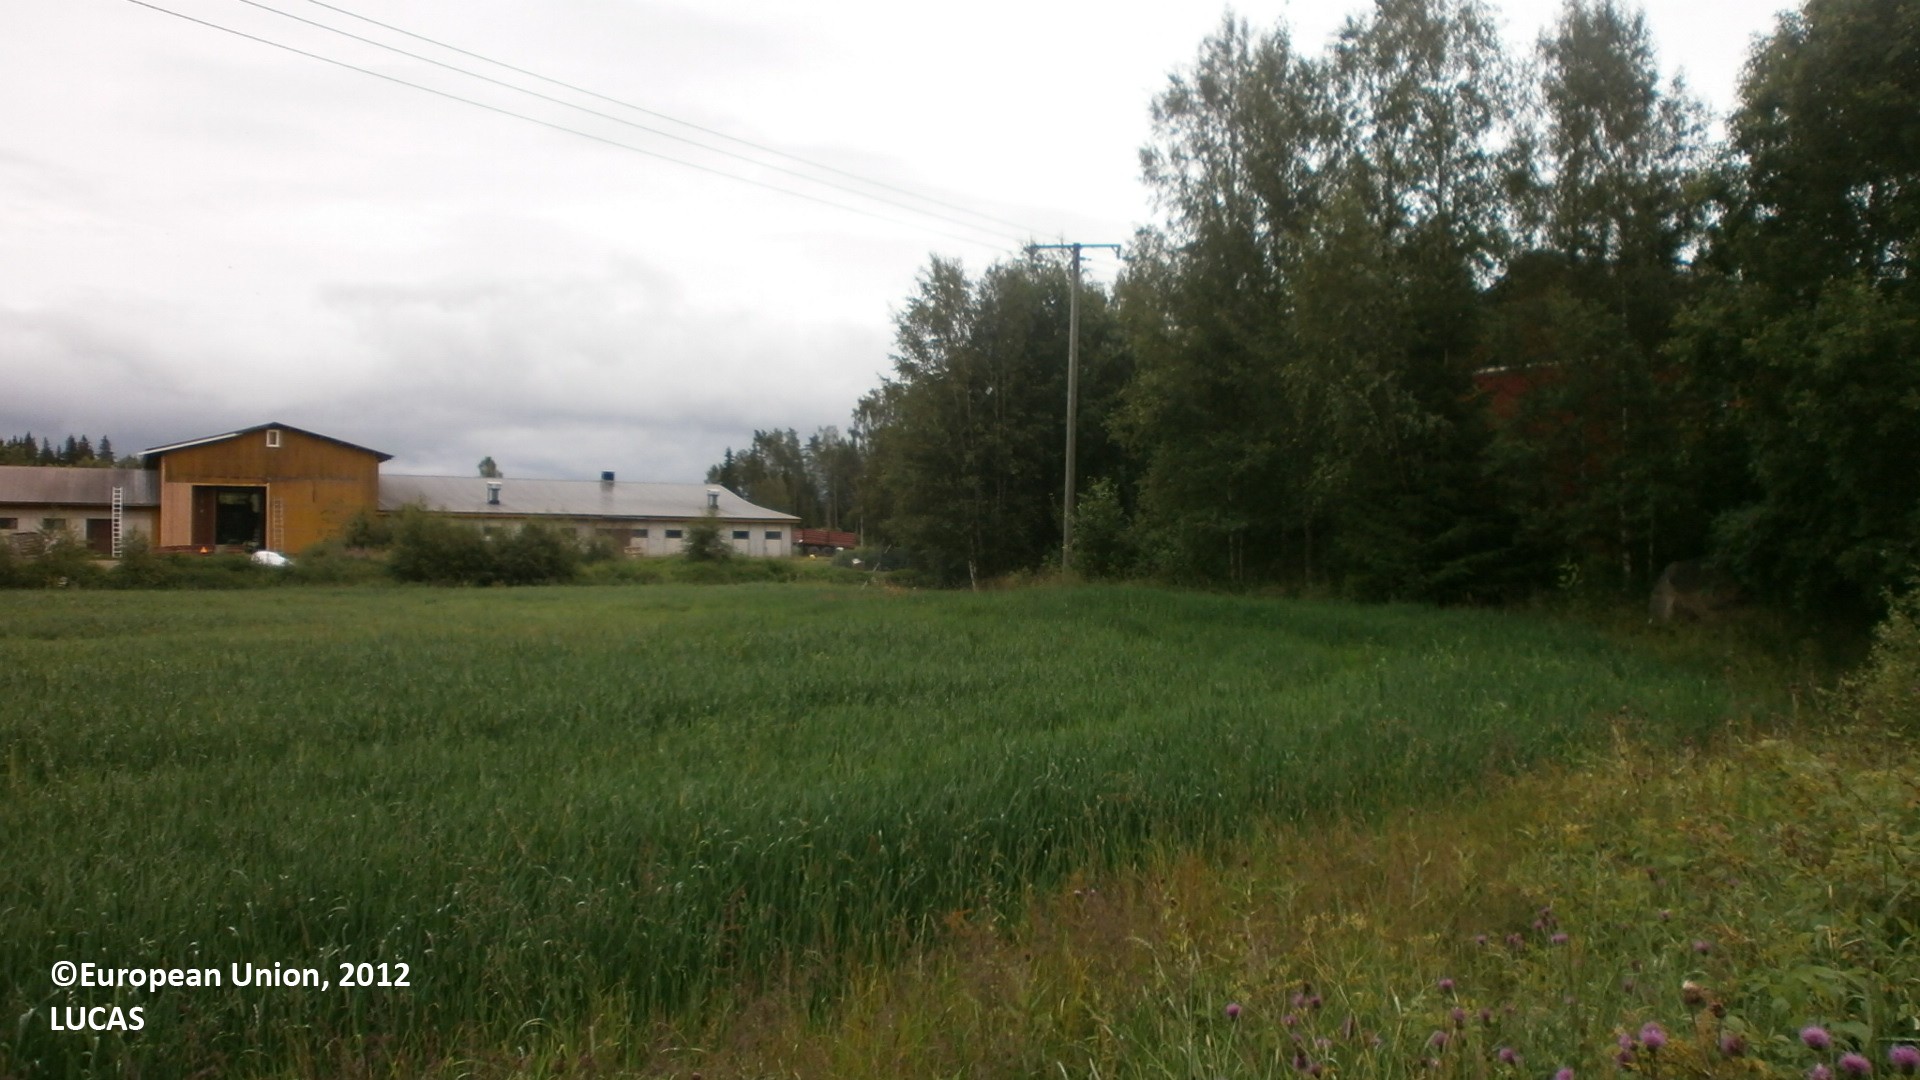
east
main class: Grassland
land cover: Grassland without tree/shrub cover
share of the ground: > 75 %
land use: Road transport
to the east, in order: Grassland without tree/shrub cover; Ditches and canals; Shruby margins; Oats; Electric lines; Oats; Shruby margins; Ditches and canals; Artificial constructions in urban areas; Shruby margins; Tracks; Shruby margins; Ditches and canals; Oats; Grassland without tree/shrub cover; Inland running water; Electric lines; Inland running water
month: July
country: FI
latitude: 63.9781
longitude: 23.7701
